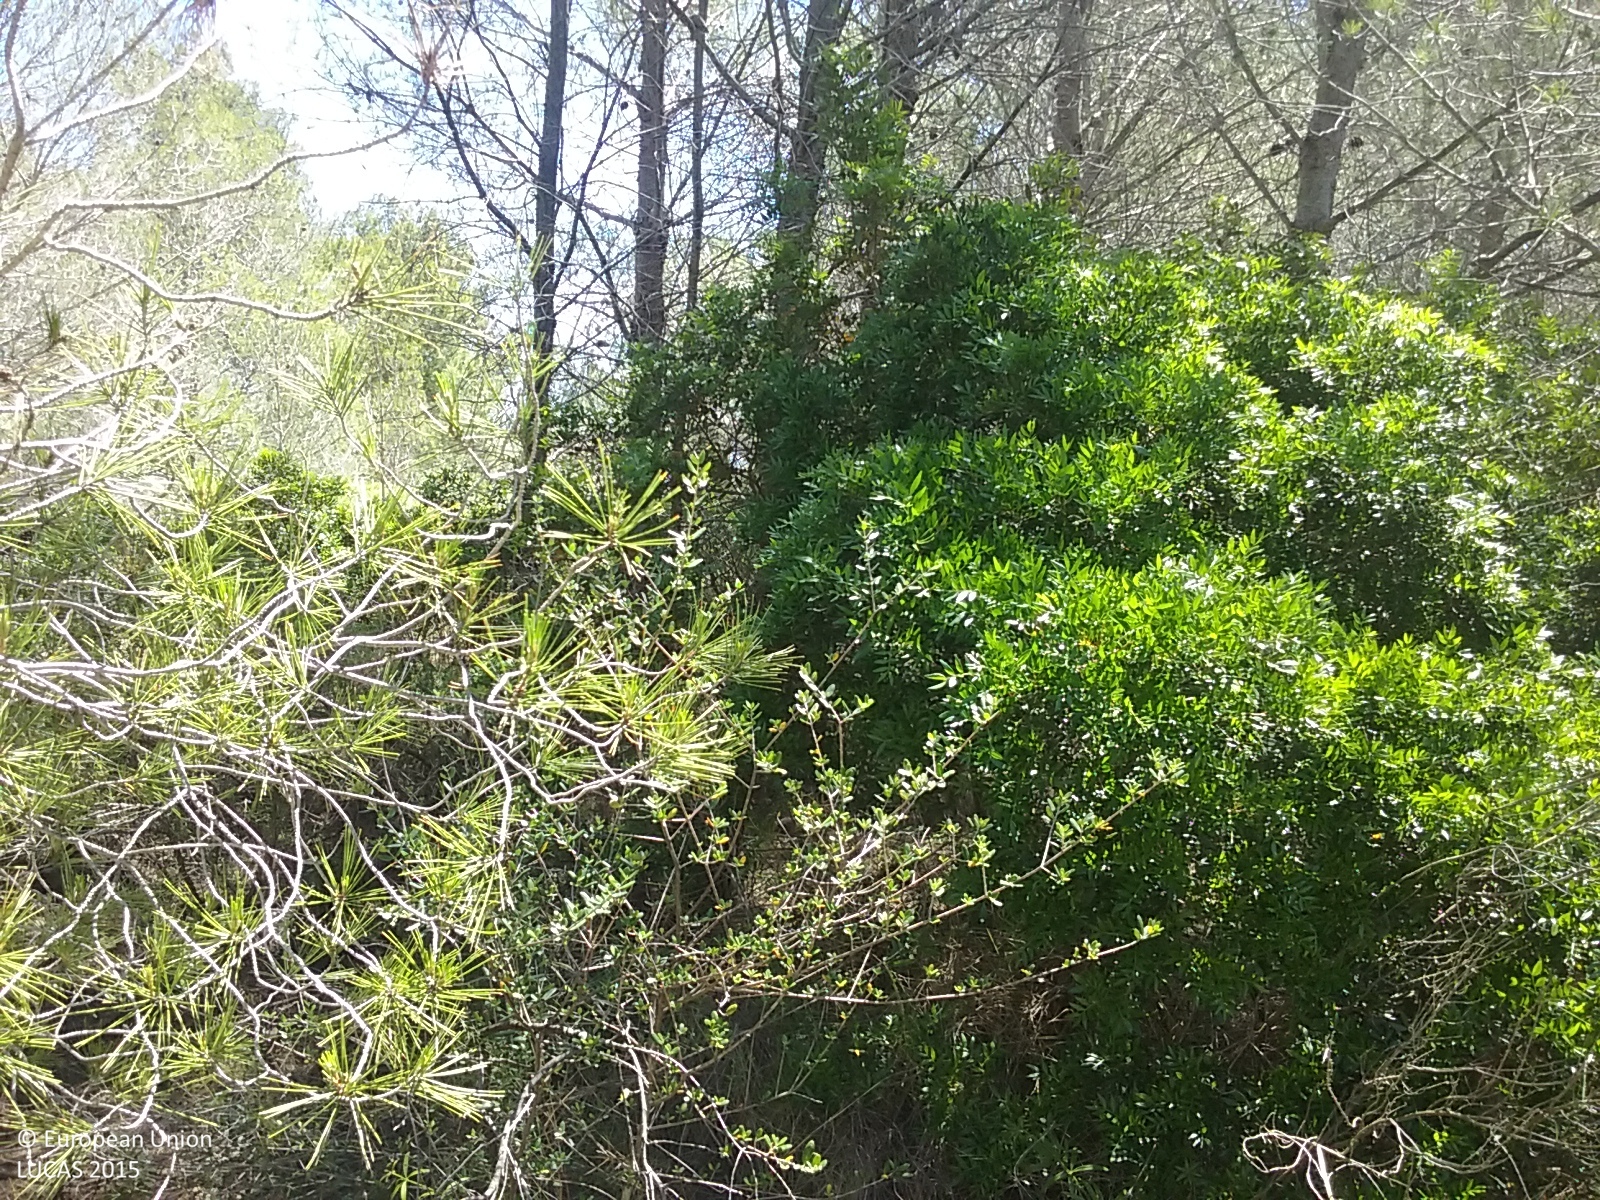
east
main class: Woodland
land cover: Pine dominated coniferous woodland
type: coniferous forest of the mediterranean region
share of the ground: 50 - 75 %
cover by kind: coniferous forest trees 50 %, shrubs 50 %
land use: Forestry
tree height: > 5 m
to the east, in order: Pine dominated coniferous woodland; Shrubland without tree cover; Dry stone walls; Pine dominated coniferous woodland; Shrubland without tree cover; Tracks; Shrubland with sparse tree cover; Dry stone walls; Shrubland with sparse tree cover; Dry stone walls; Shrubland with sparse tree cover; Dry stone walls; Pine dominated coniferous woodland; Shrubland without tree cover
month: May
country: ES
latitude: 40.2993
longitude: 0.3387
